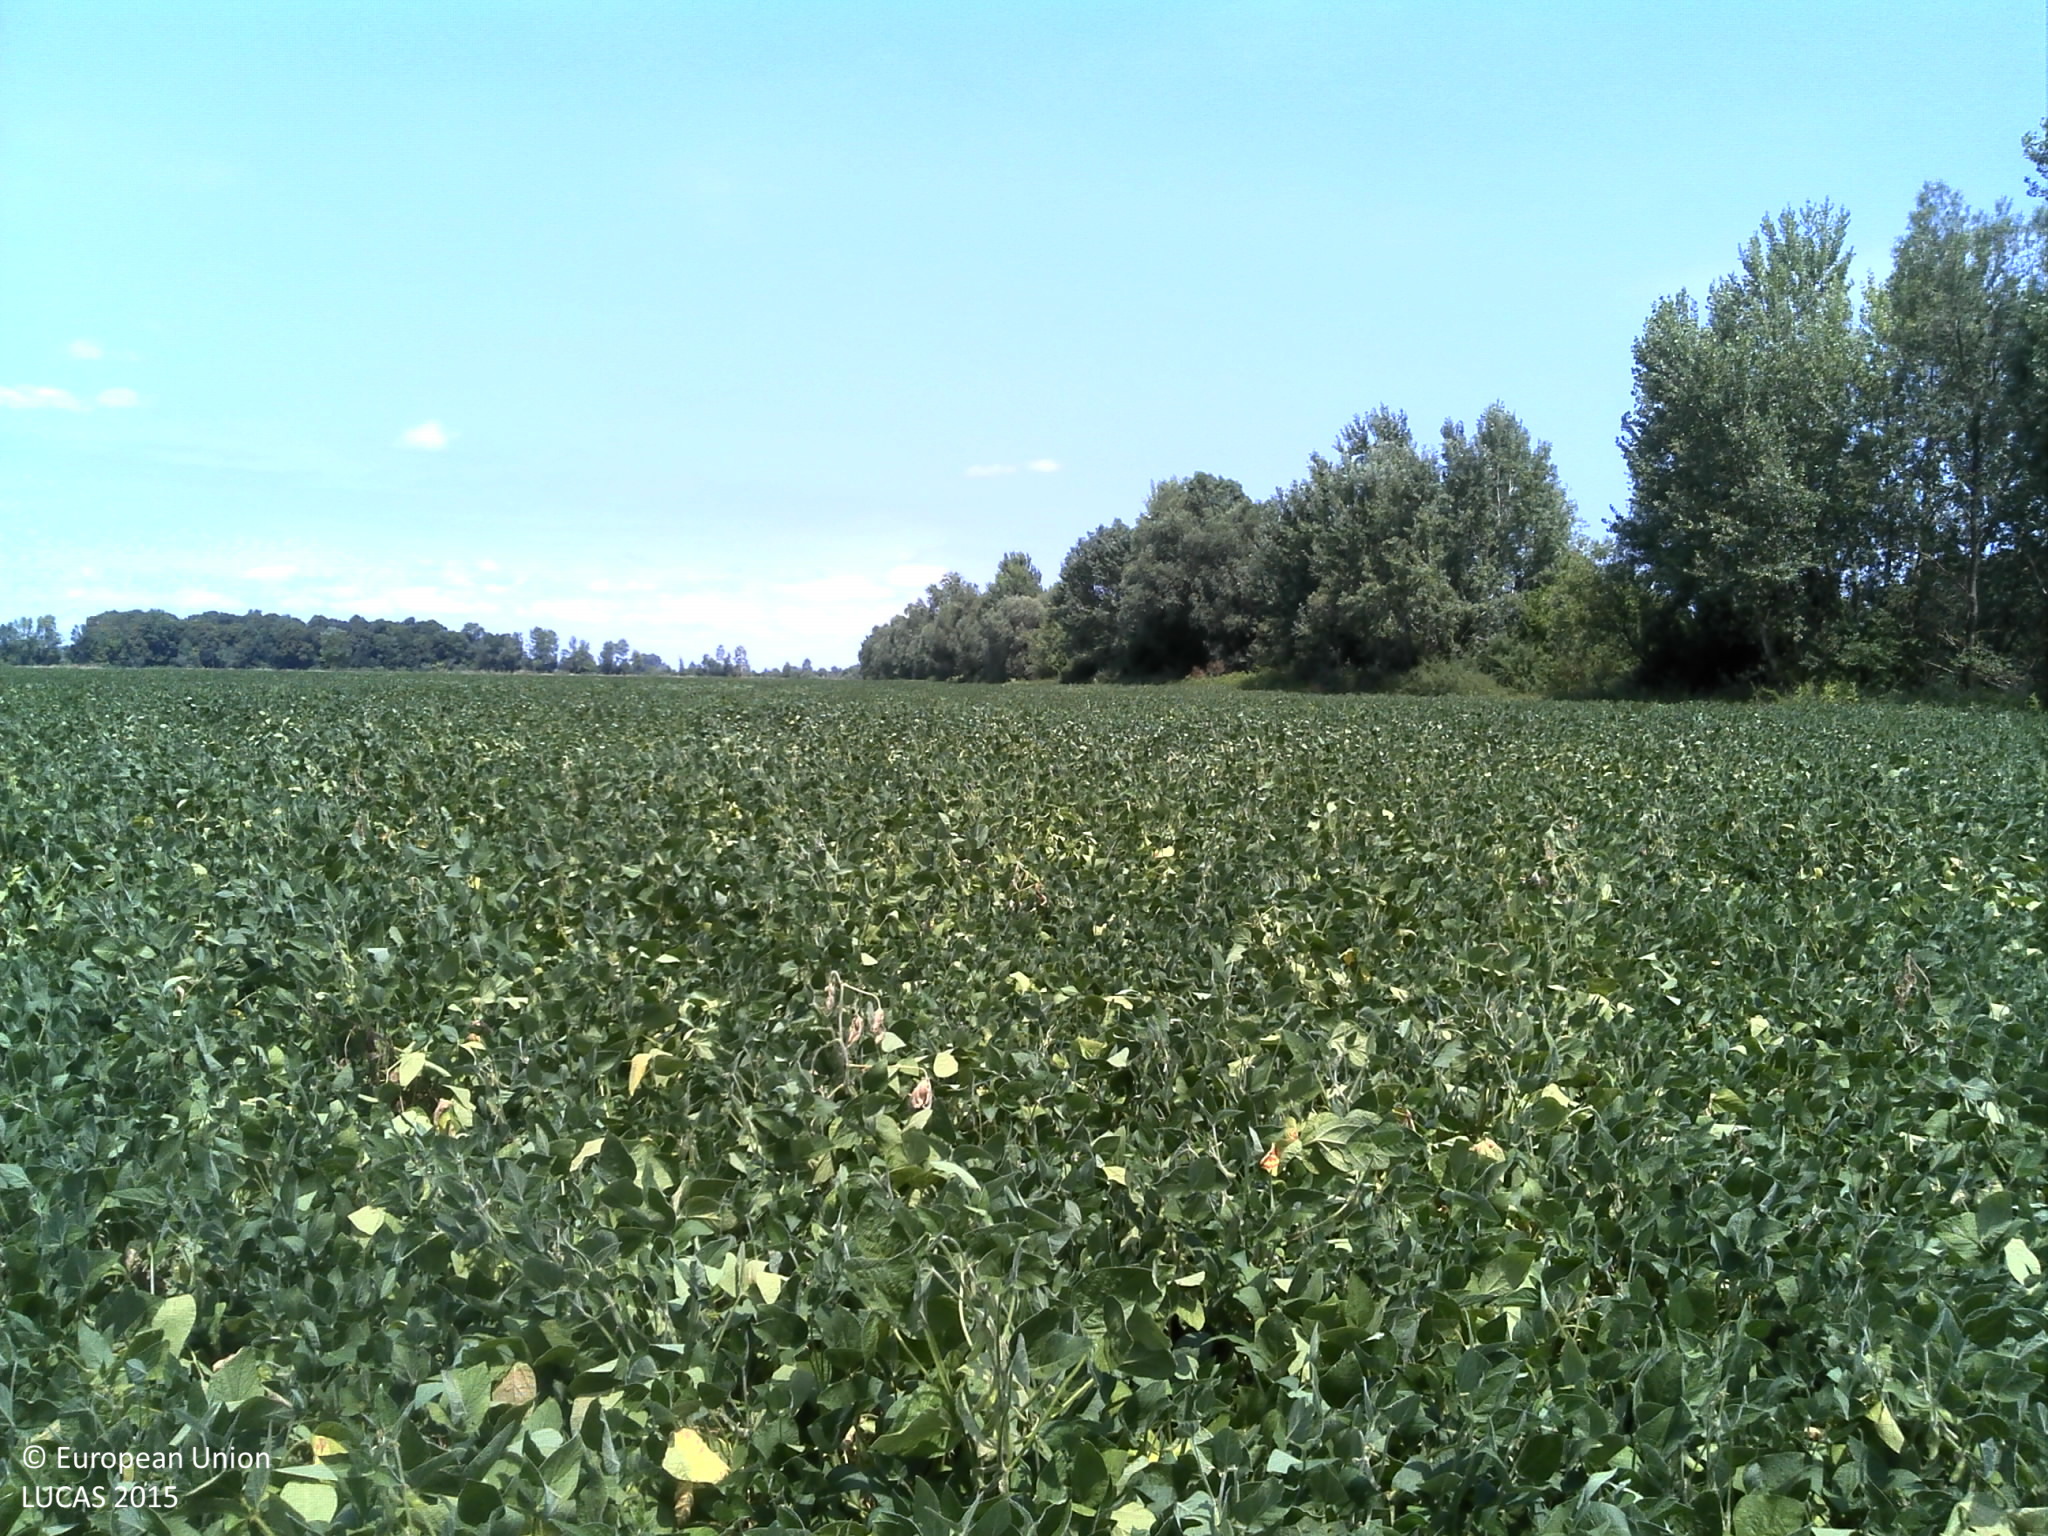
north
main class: Cropland
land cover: Soya
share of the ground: > 75 %
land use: Agriculture (excluding fallow land and kitchen gardens)
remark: Tilled/Sowed
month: July
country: HR
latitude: 44.9052
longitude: 18.9605
